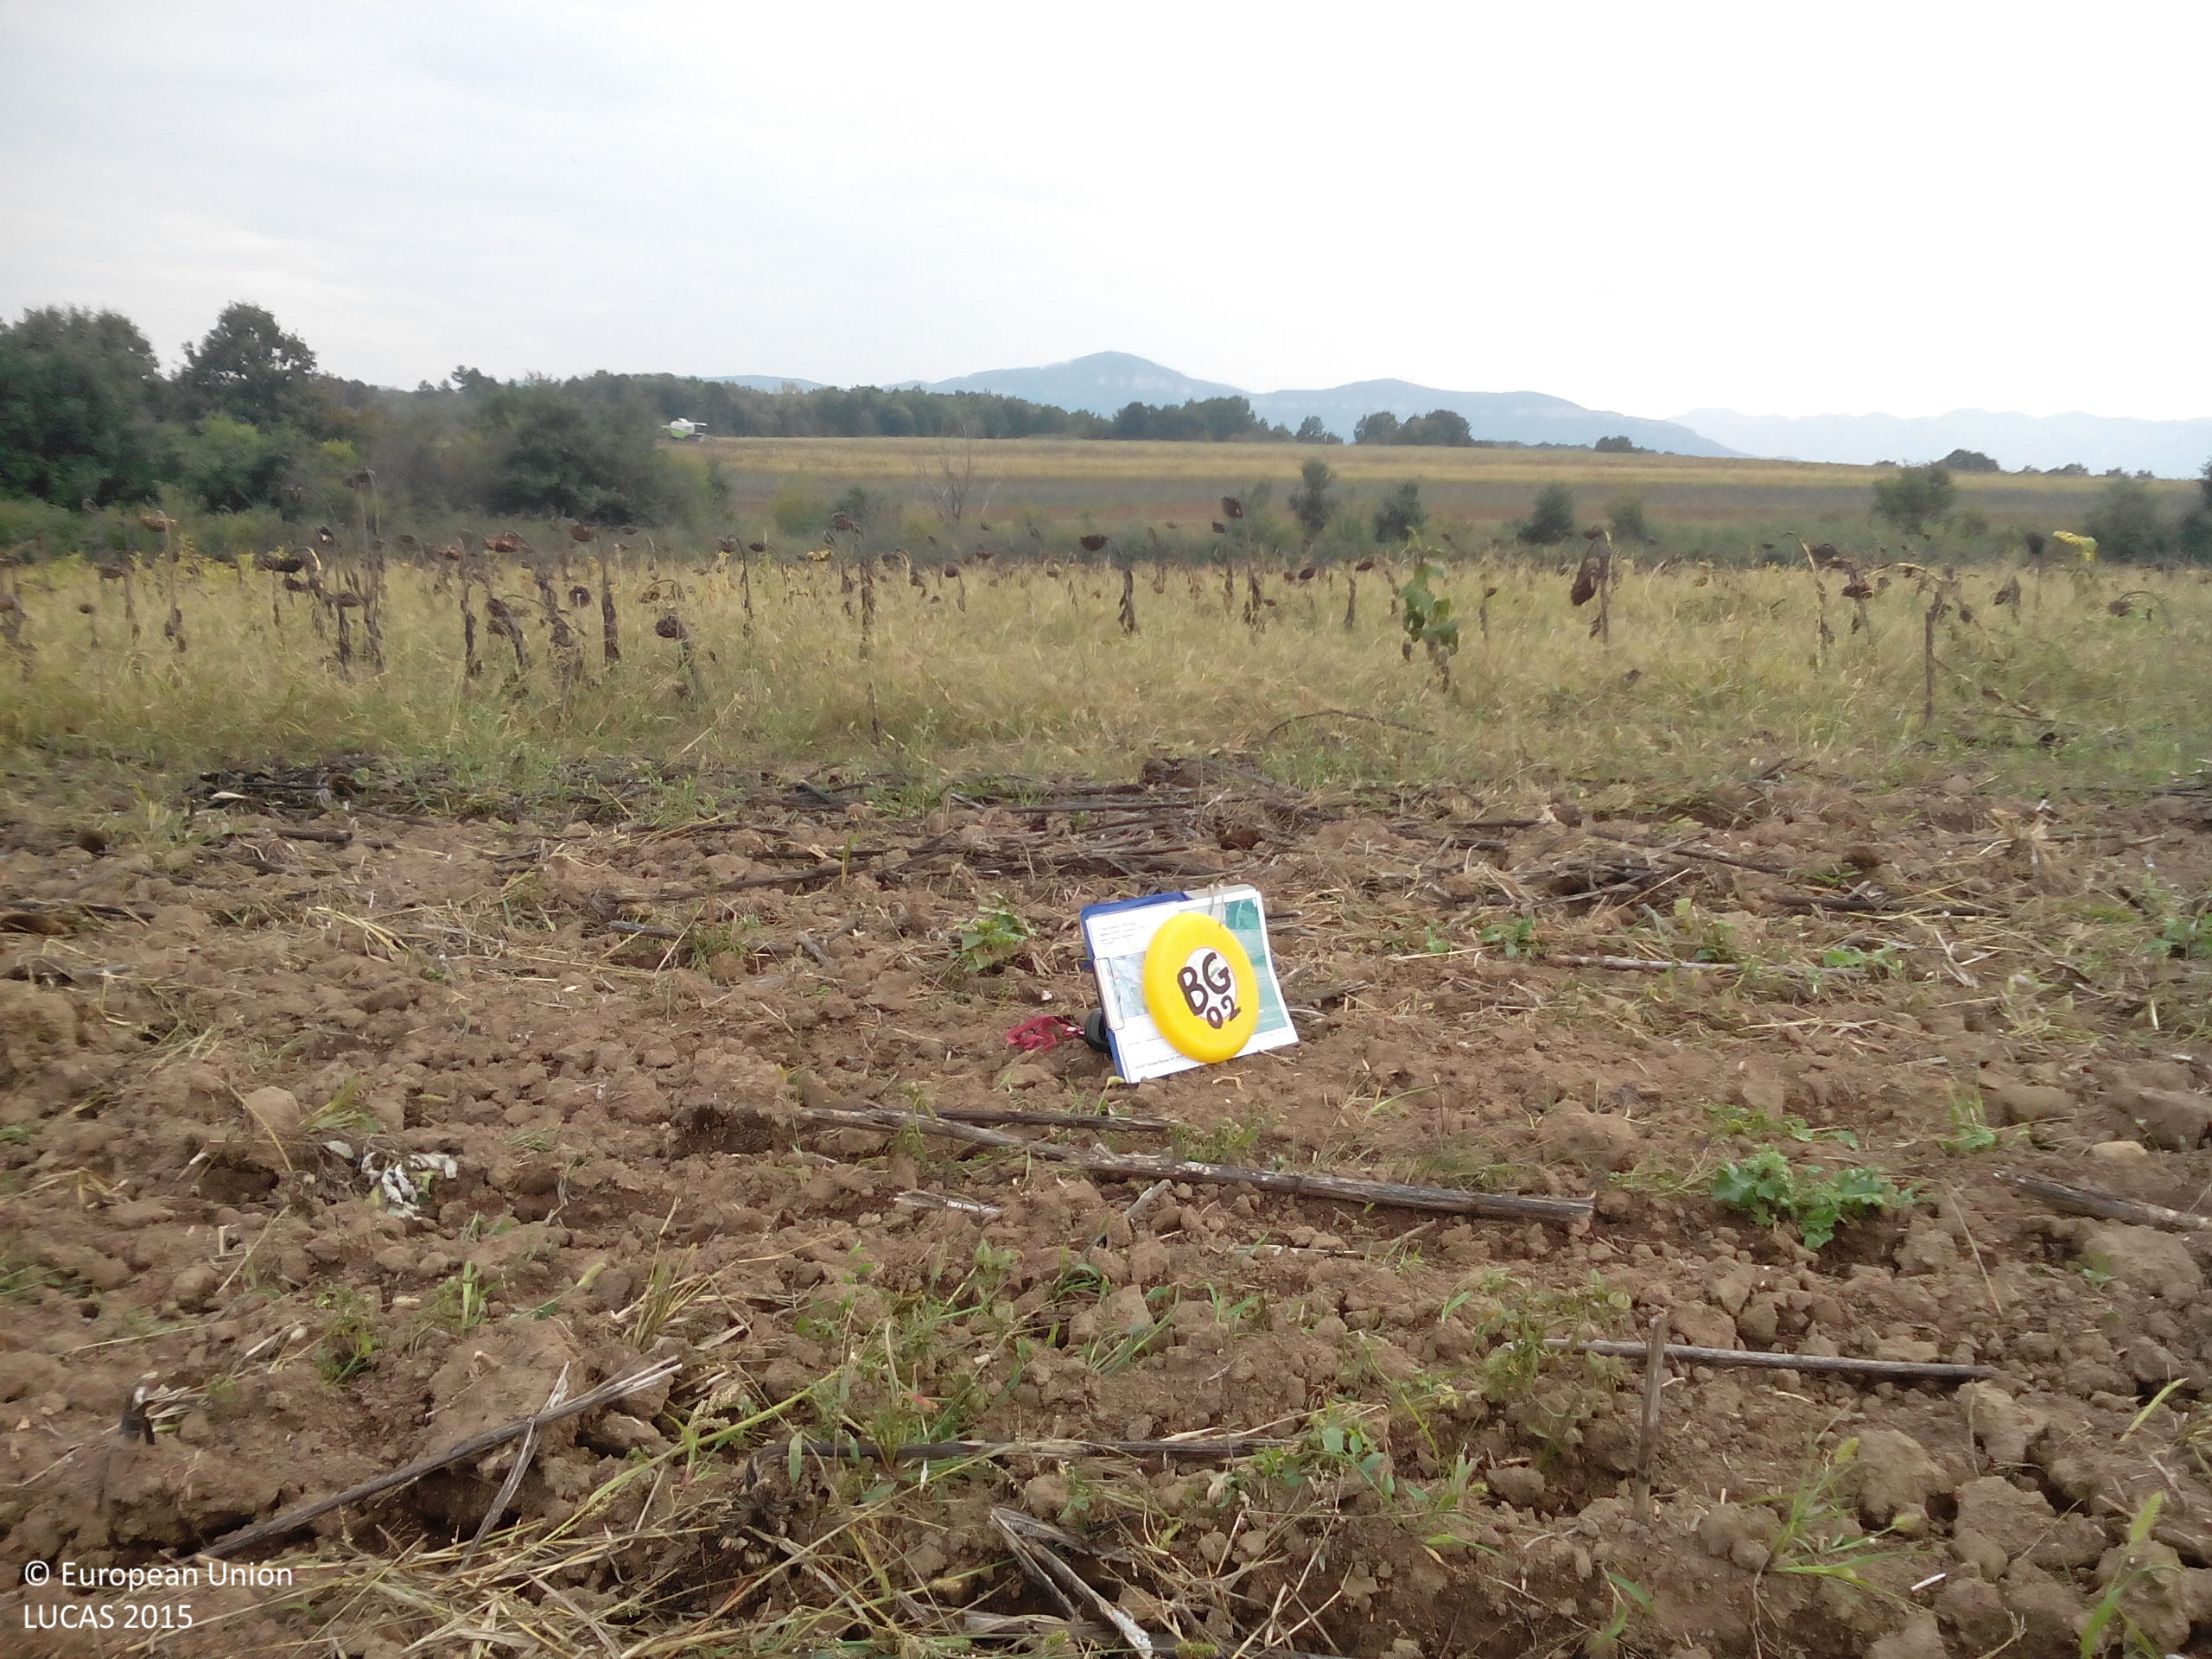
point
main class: Cropland
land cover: Sunflower
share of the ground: < 10 %
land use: Agriculture (excluding fallow land and kitchen gardens)
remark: Harvested field
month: October
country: BG
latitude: 43.3019
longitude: 23.6169
